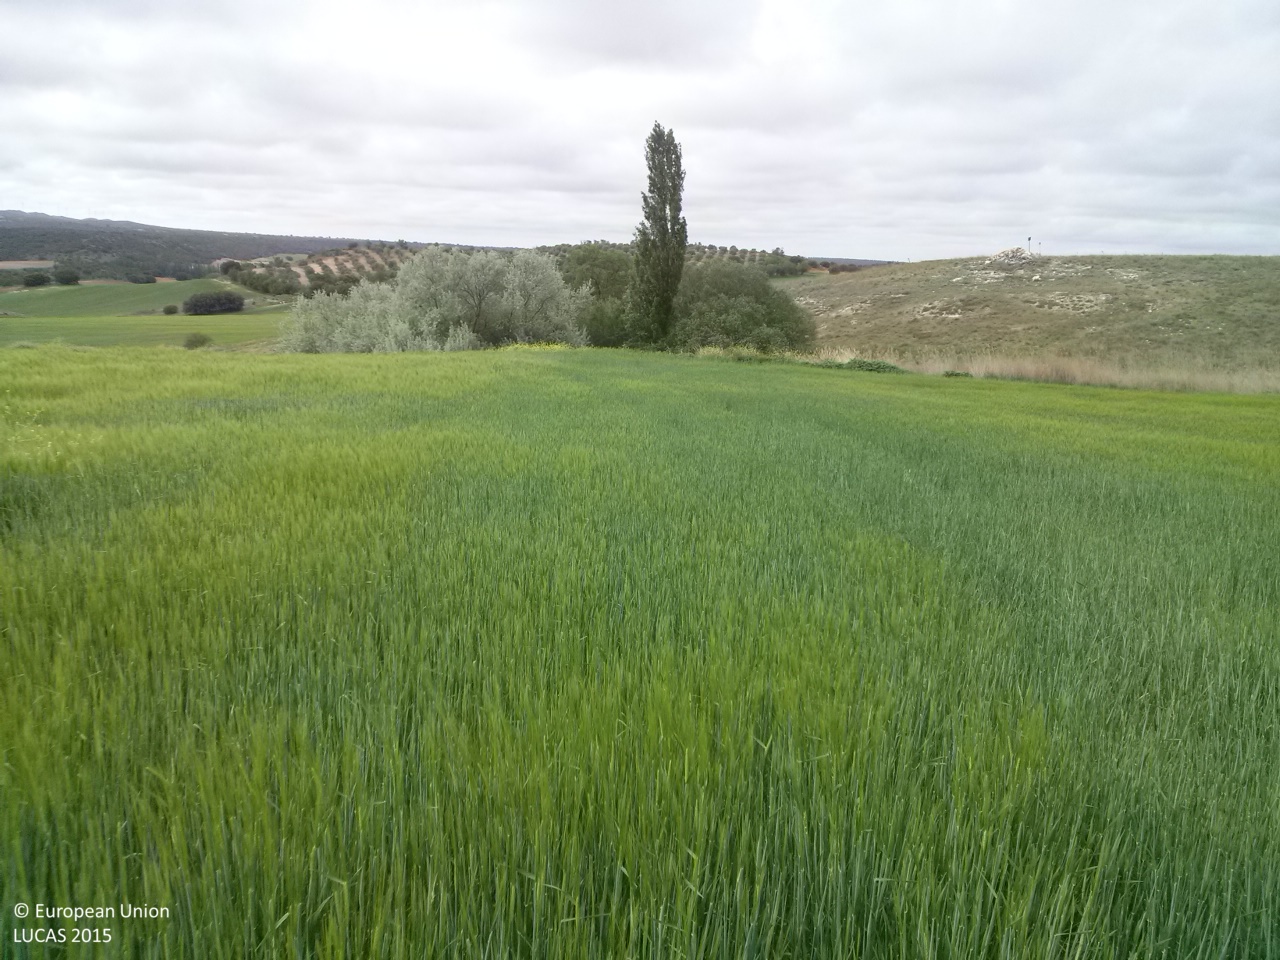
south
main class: Cropland
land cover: Barley
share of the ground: > 75 %
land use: Agriculture (excluding fallow land and kitchen gardens)
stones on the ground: < 10 %
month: May
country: ES
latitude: 39.8555
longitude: -2.8661
